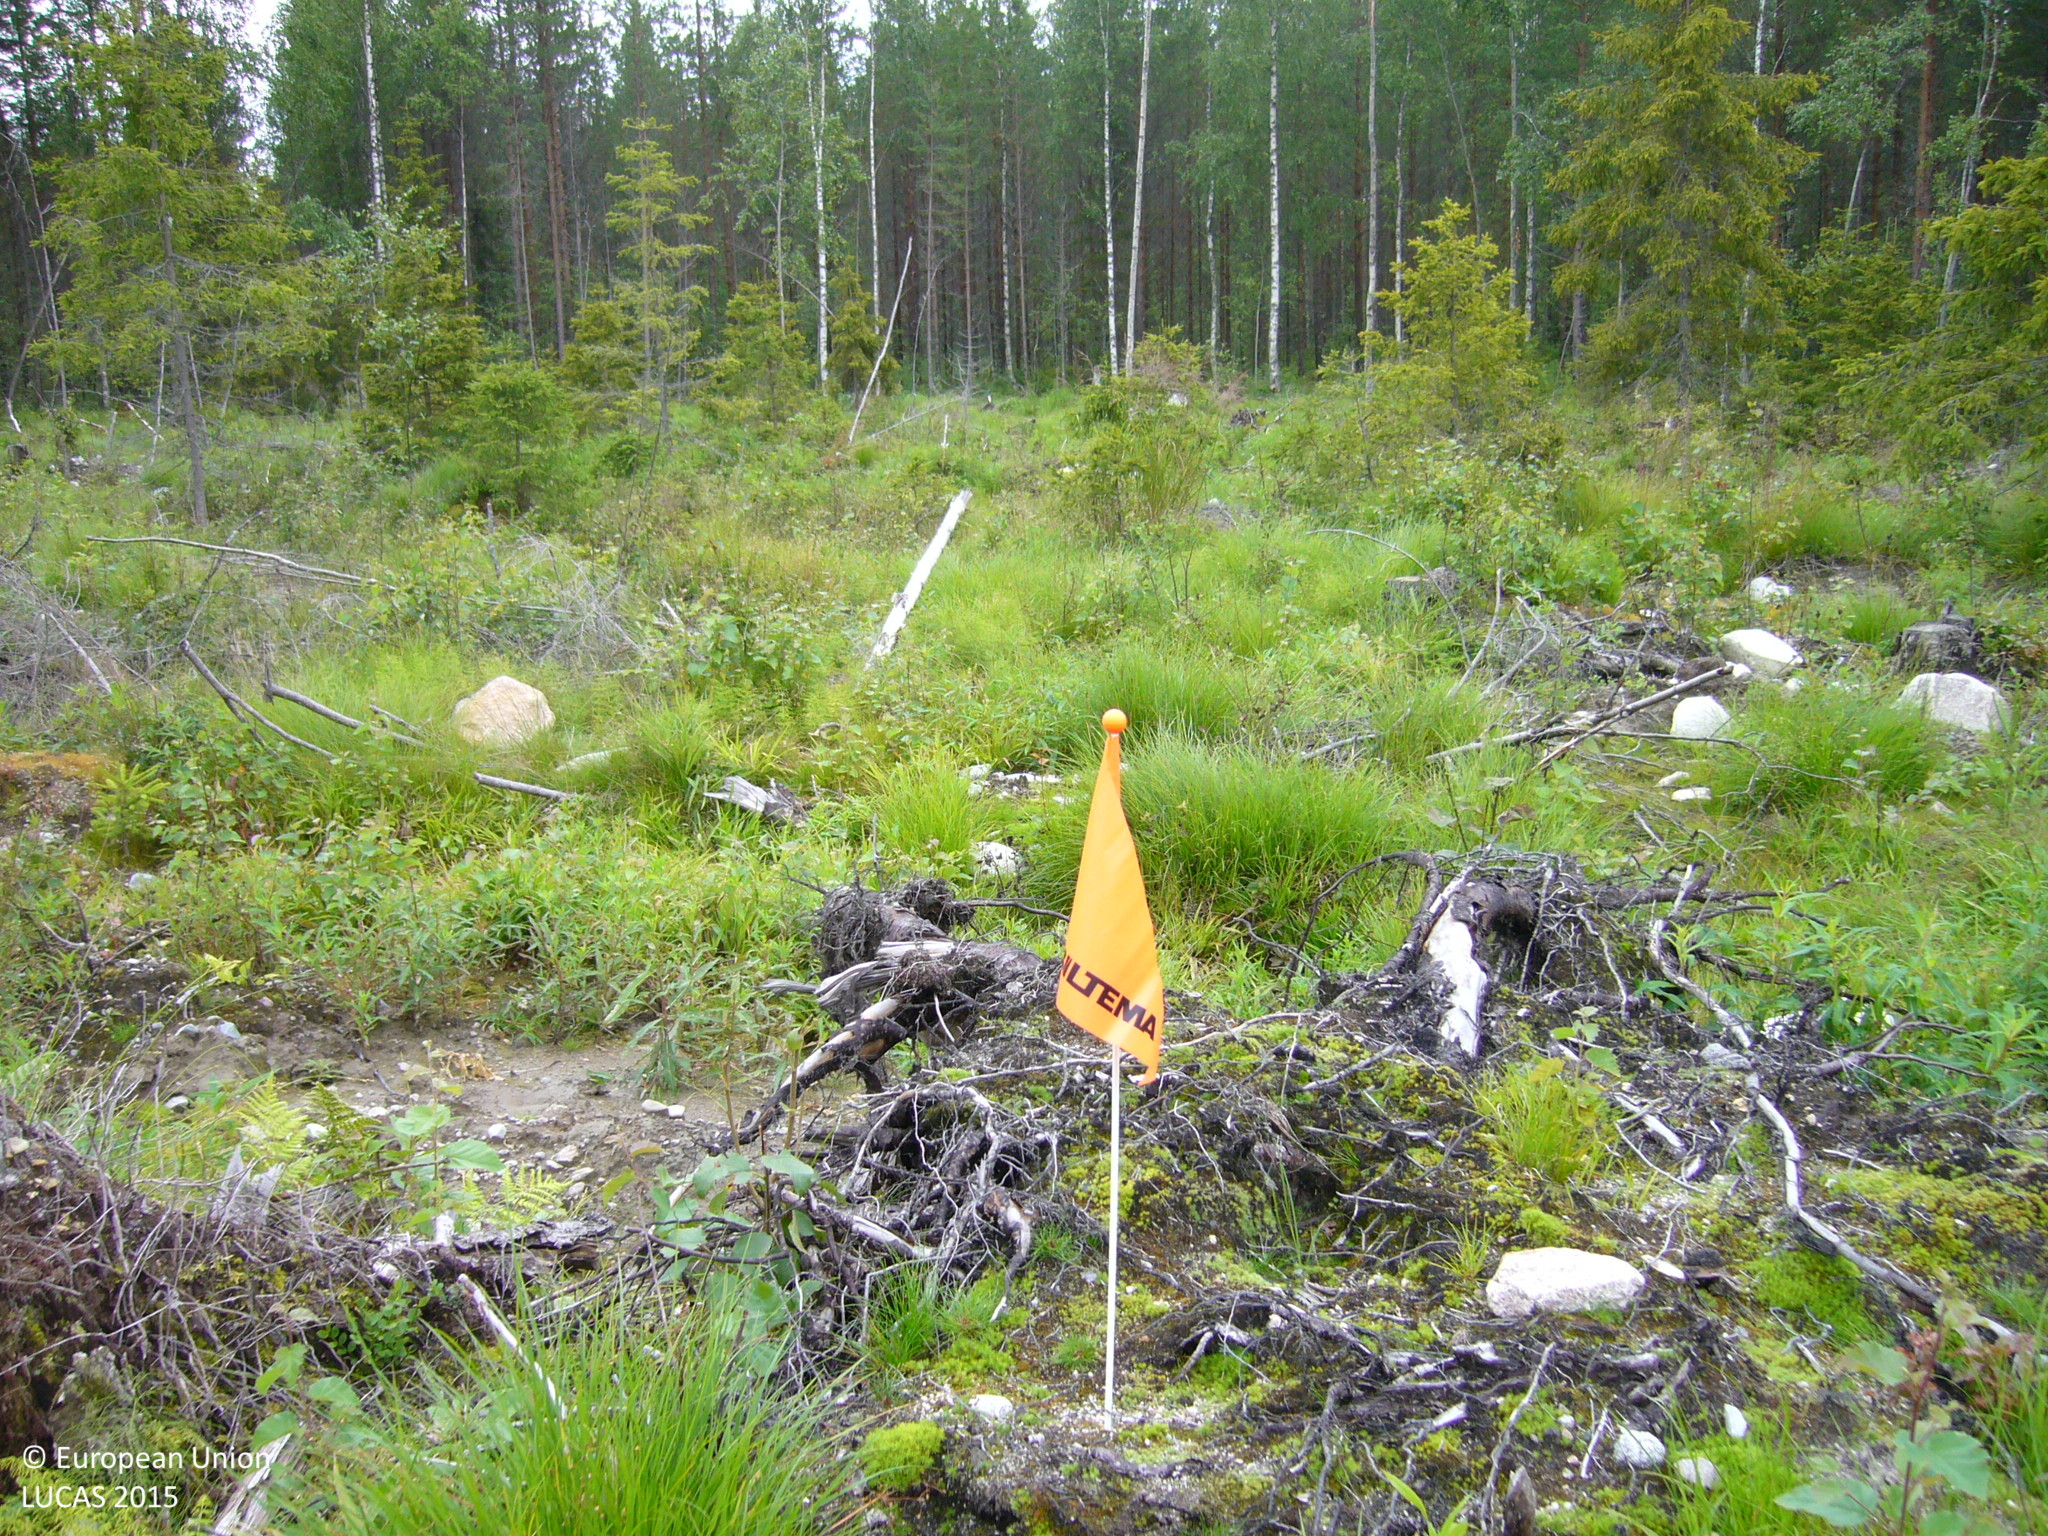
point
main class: Grassland
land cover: Grassland with sparse tree/shrub cover
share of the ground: > 75 %
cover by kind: herbaceous plants 50 %, consolidated bare surface 25 %, unconsolidated bare surface 20 %, coniferous forest trees 5 %
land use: Forestry
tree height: < 5 m
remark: Clear cut
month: July
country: FI
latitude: 64.0579
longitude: 26.1953
